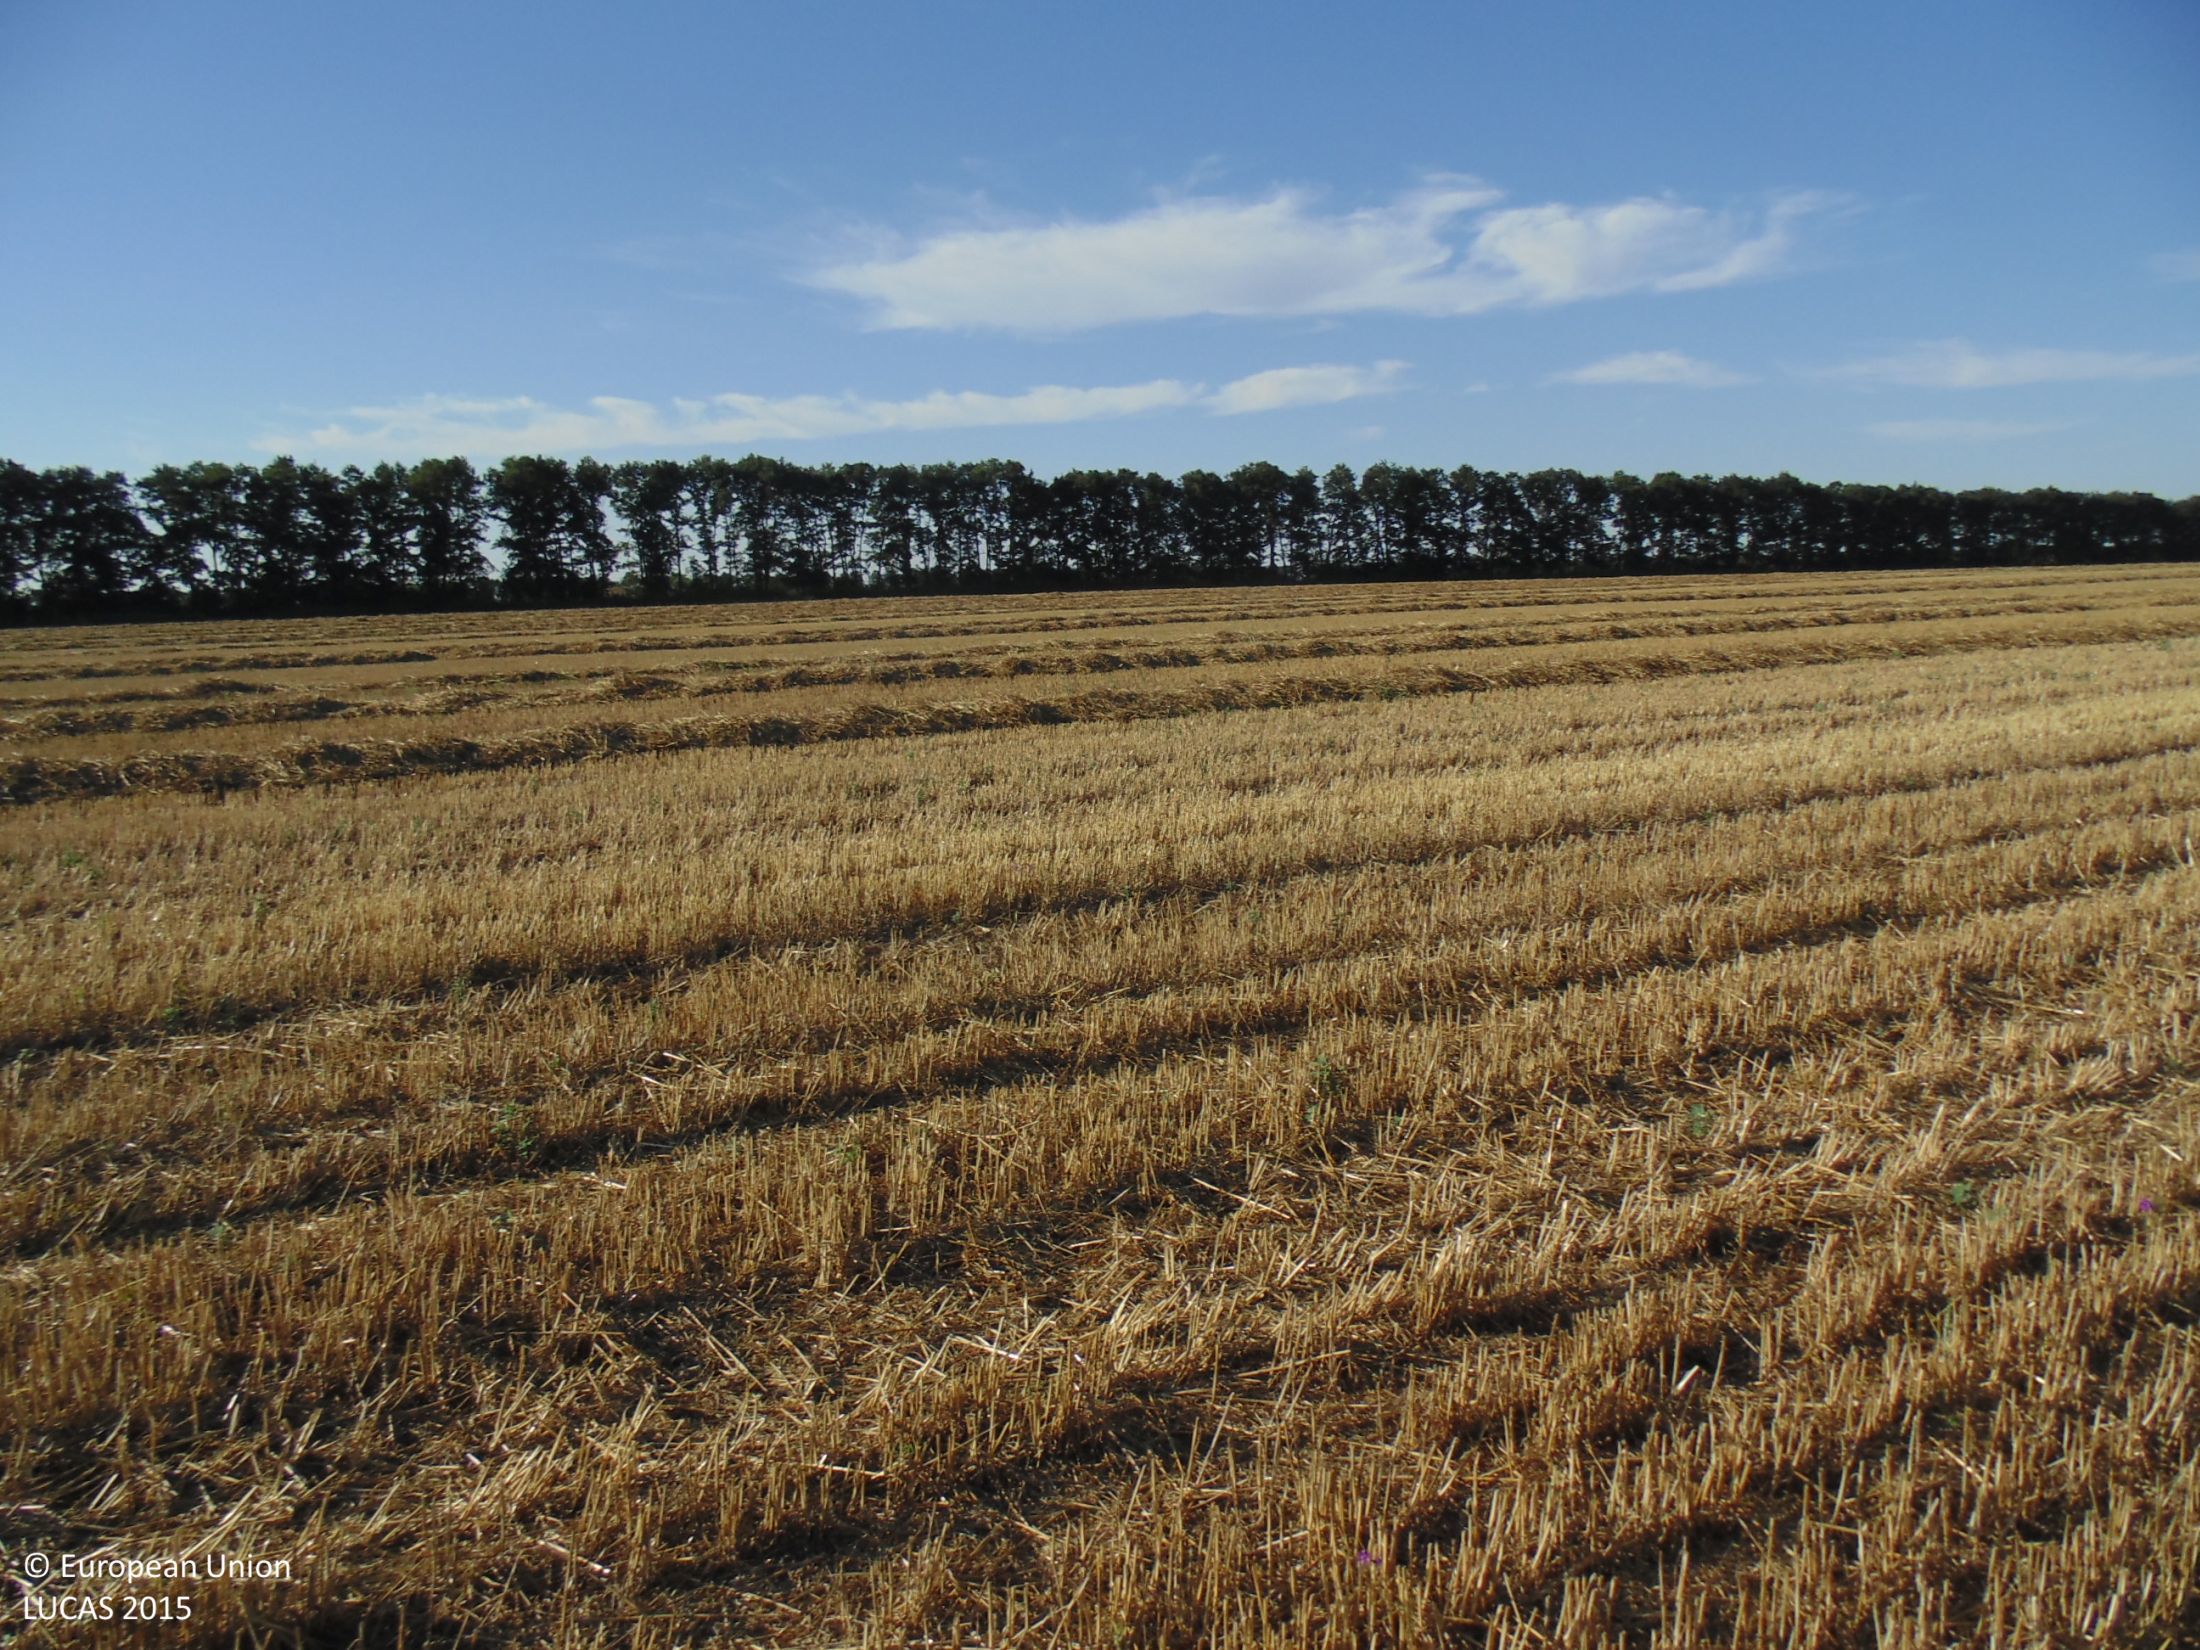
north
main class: Cropland
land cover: Common wheat
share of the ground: 50 - 75 %
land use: Agriculture (excluding fallow land and kitchen gardens)
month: August
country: BG
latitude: 43.7258
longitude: 27.7565
